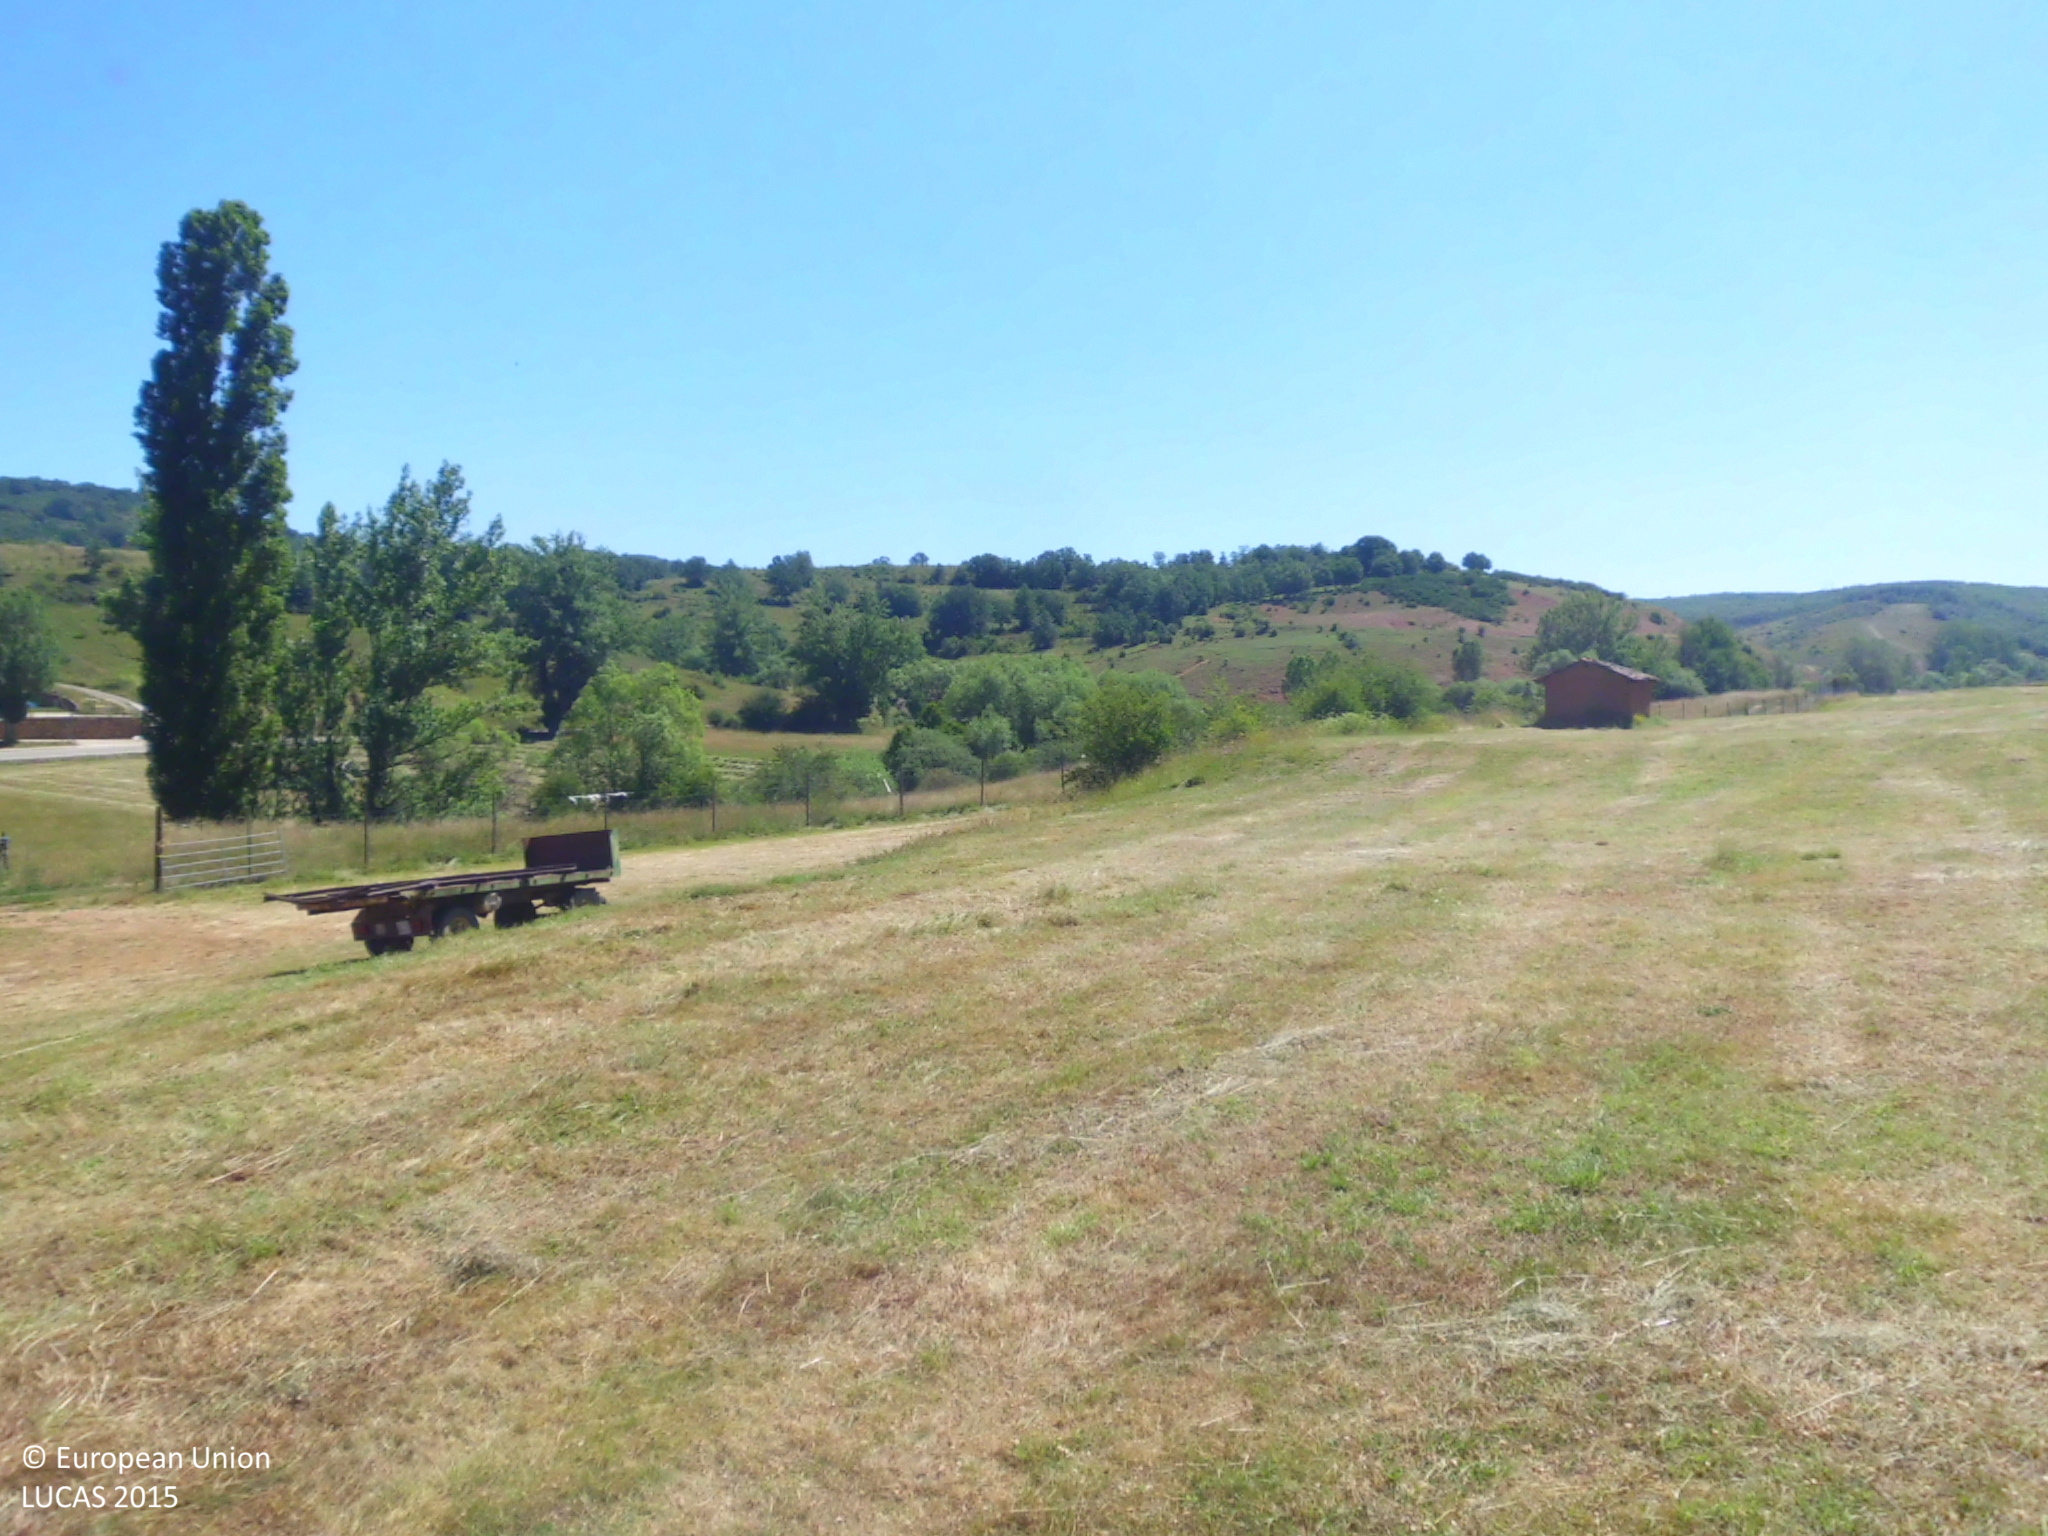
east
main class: Grassland
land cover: Grassland with sparse tree/shrub cover
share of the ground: > 75 %
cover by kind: herbaceous plants 80 %, unconsolidated bare surface 15 %, broadleaved forest trees 5 %
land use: Agriculture (excluding fallow land and kitchen gardens)
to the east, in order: Grassland with sparse tree/shrub cover; Fences; Grassland without tree/shrub cover; Fences; Tracks; Grassland with sparse tree/shrub cover; Broadleaved woodland; Rivers and streams; Grassland without tree/shrub cover
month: June
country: ES
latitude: 42.7855
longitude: -4.9393
